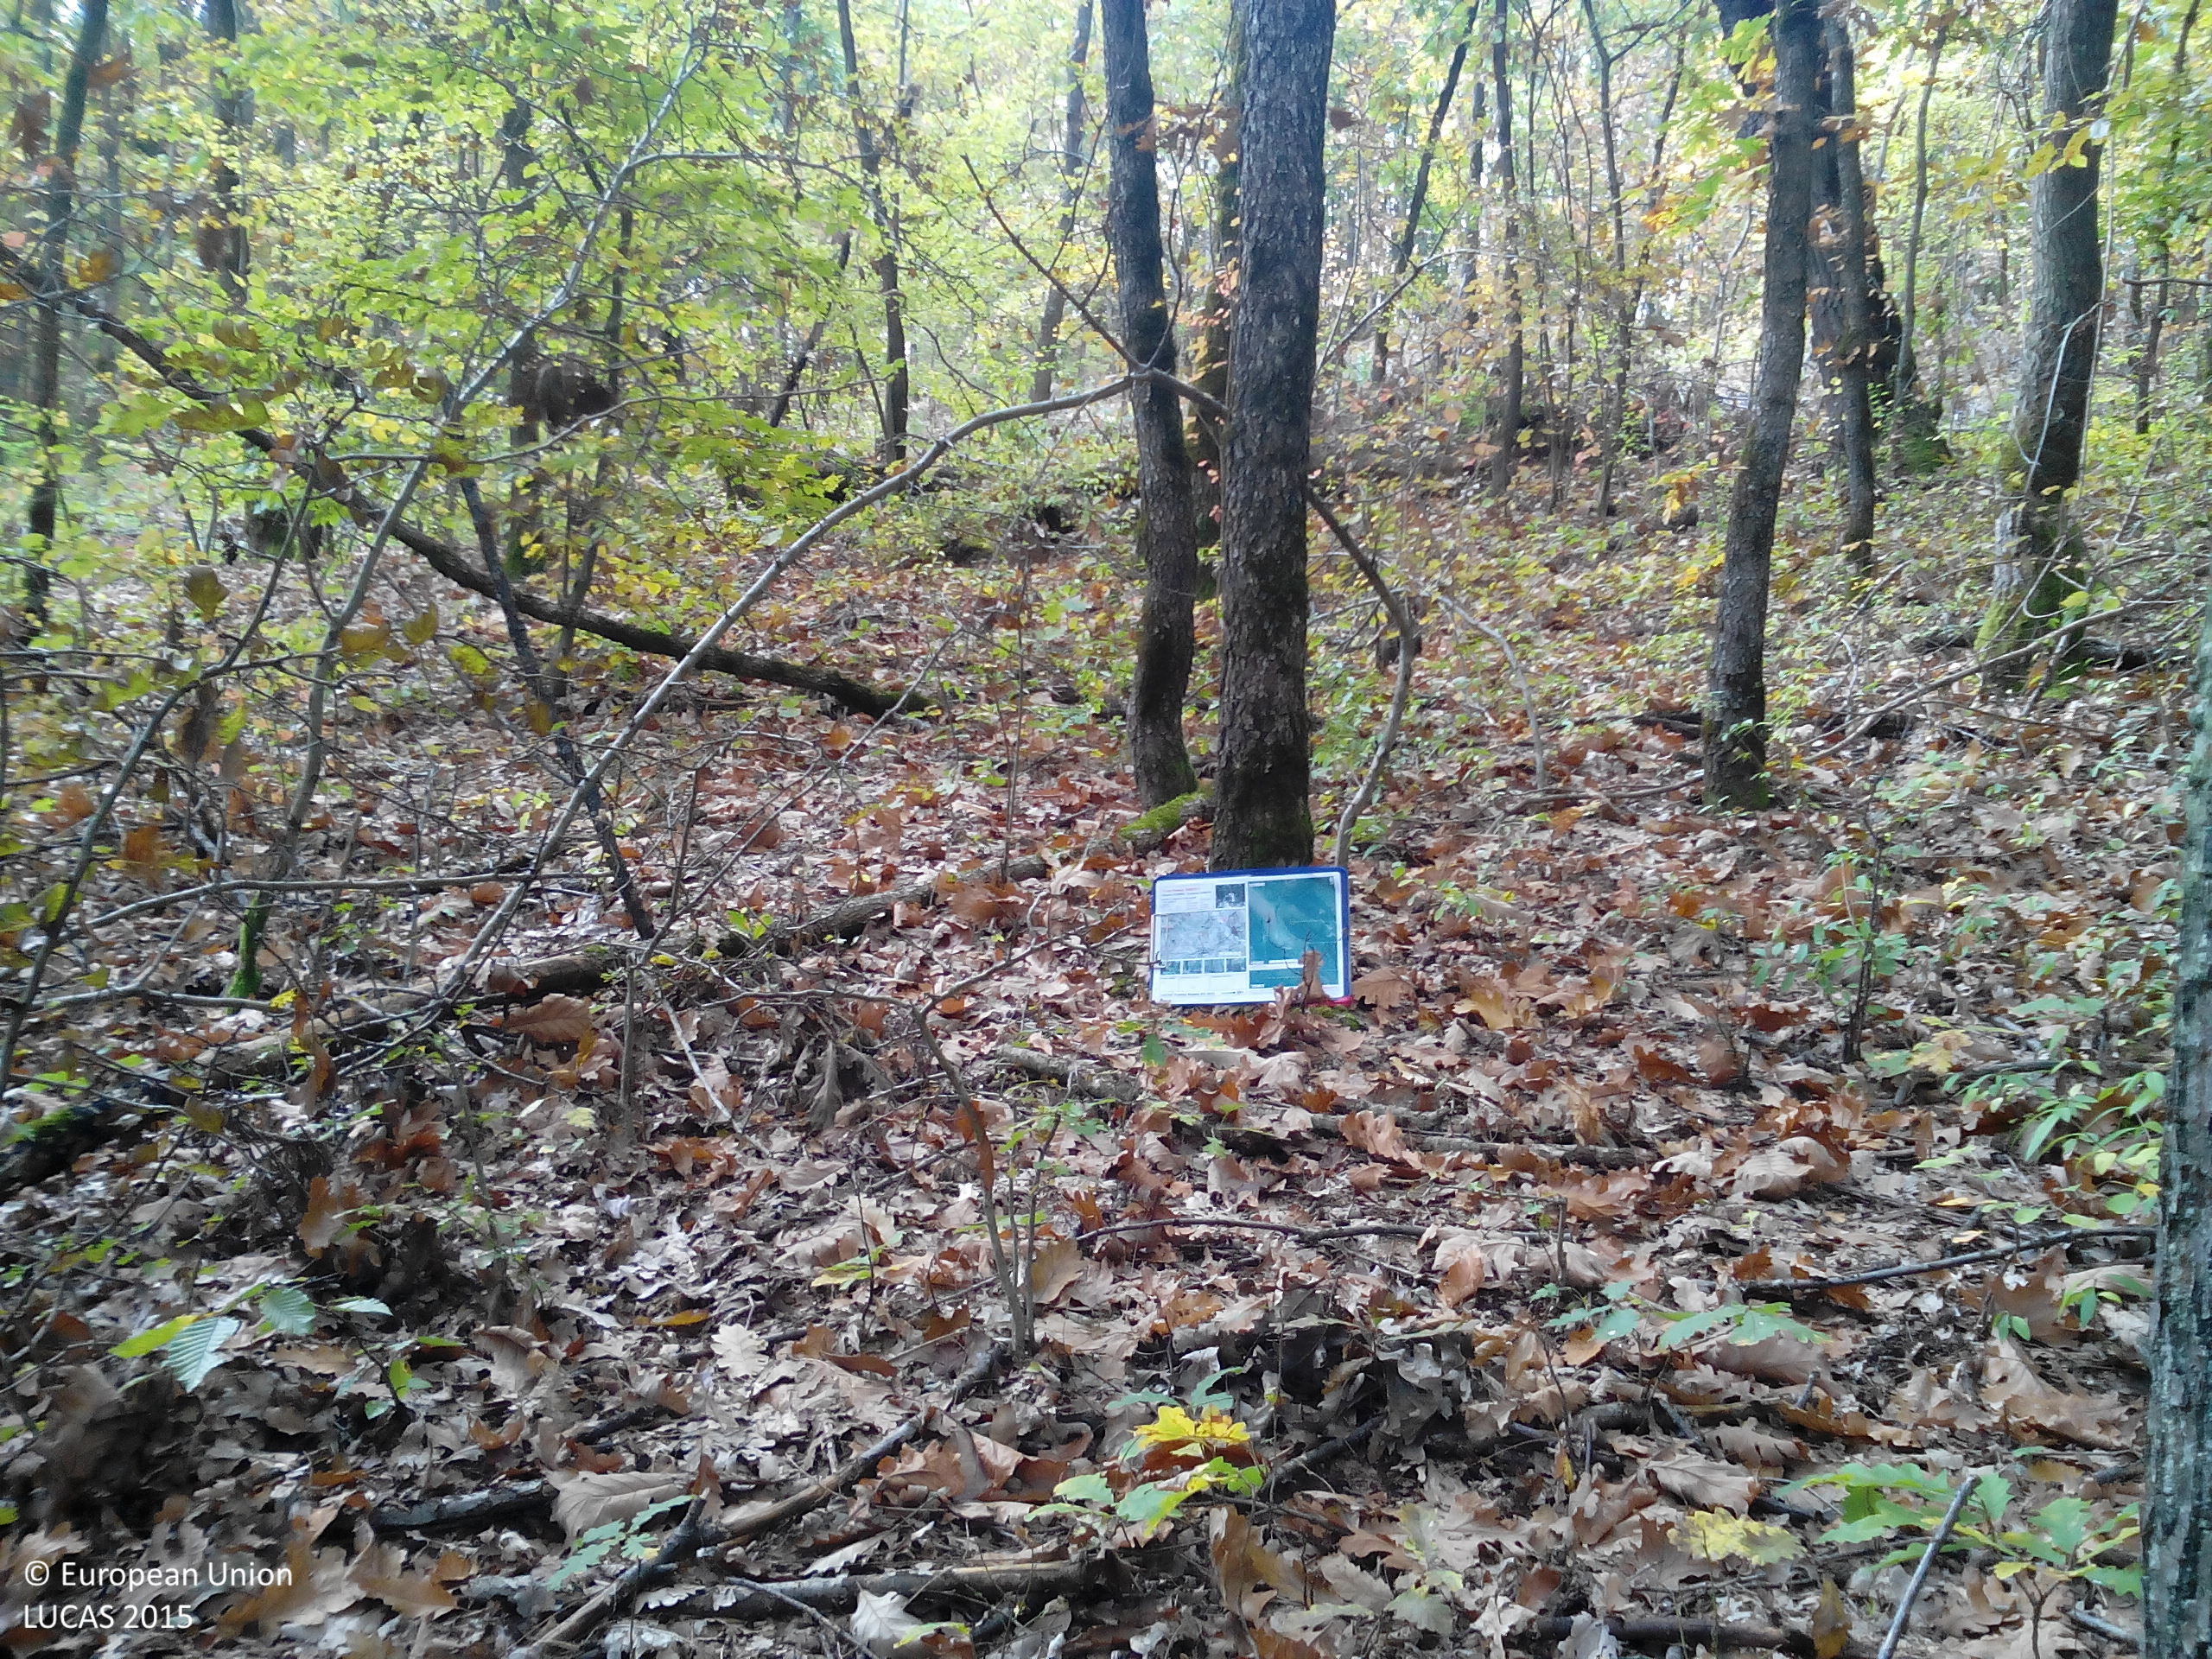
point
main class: Woodland
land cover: Broadleaved woodland
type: acidophilous oak and oak-birch forest
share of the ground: > 75 %
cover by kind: broadleaved forest trees 95 %, shrubs 5 %
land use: Forestry
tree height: > 5 m
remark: Clear cut
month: October
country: BG
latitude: 42.9558
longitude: 24.0093
